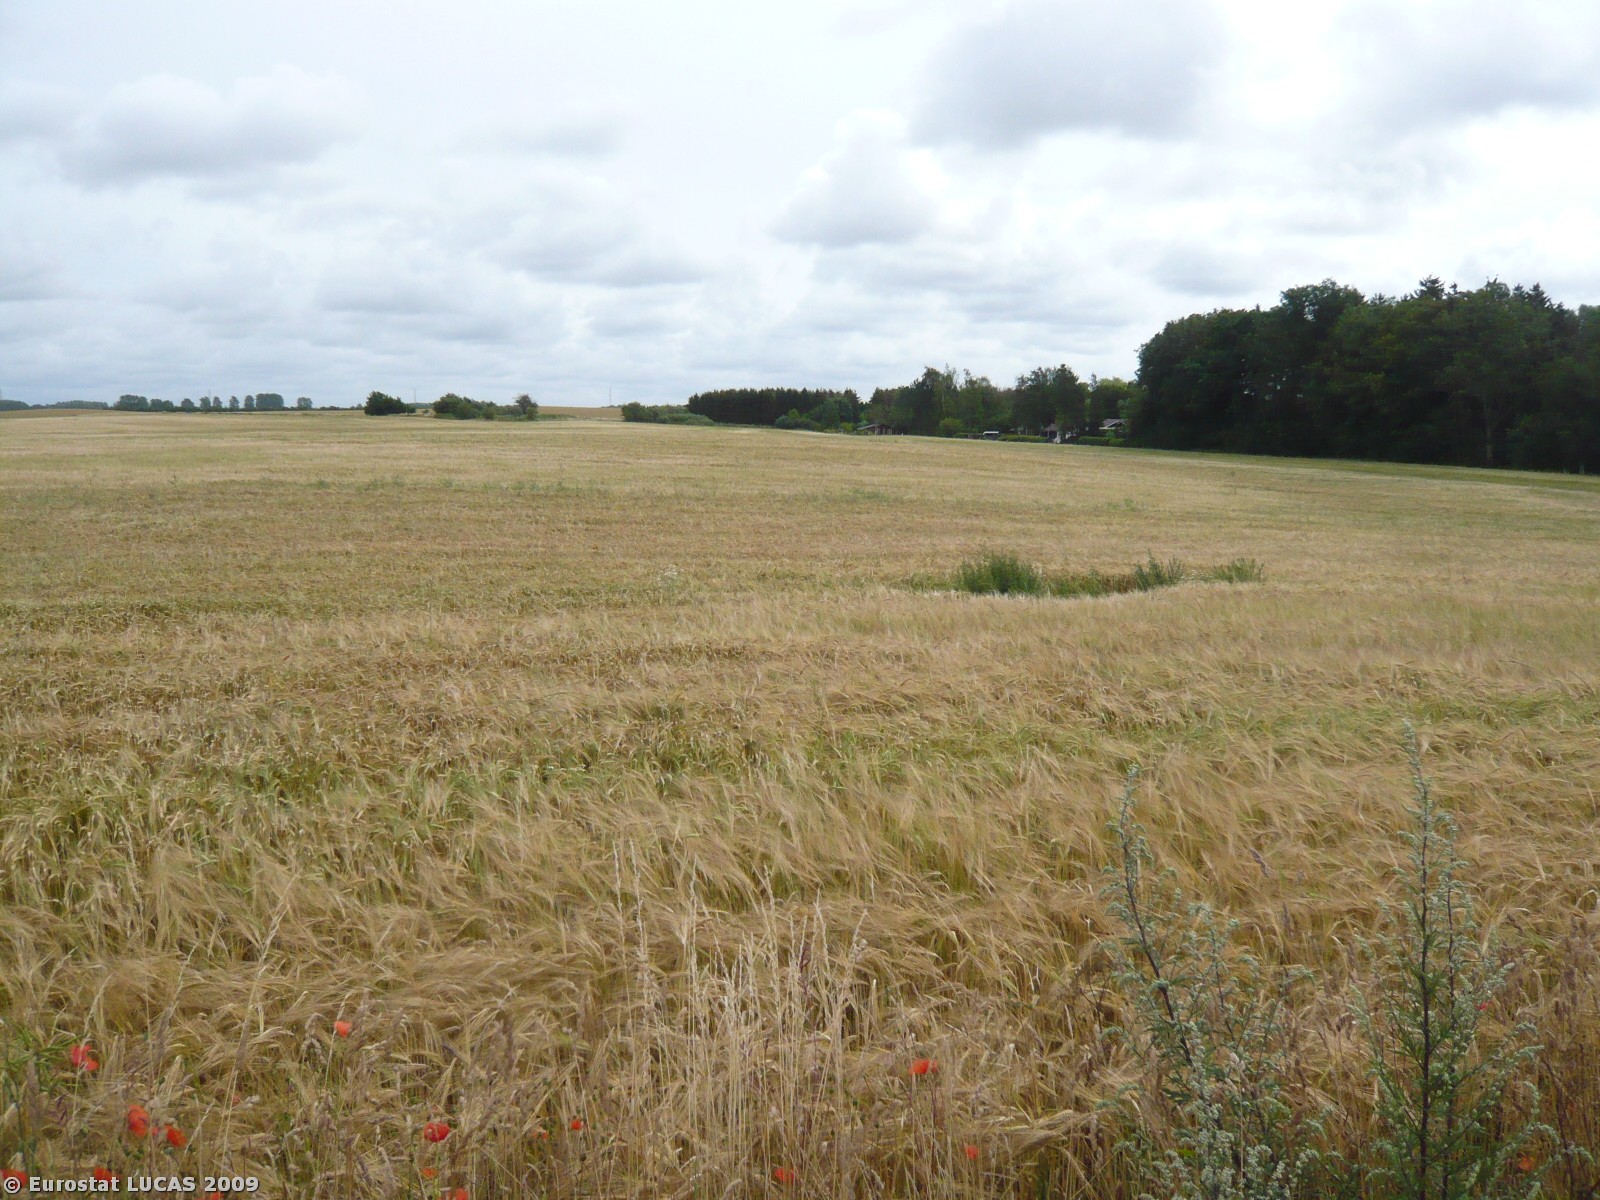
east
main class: Cropland
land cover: Barley
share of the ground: > 75 %
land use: Agriculture (excluding fallow land and kitchen gardens)
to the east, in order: Barley
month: July
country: DK
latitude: 55.6838
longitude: 12.1771
